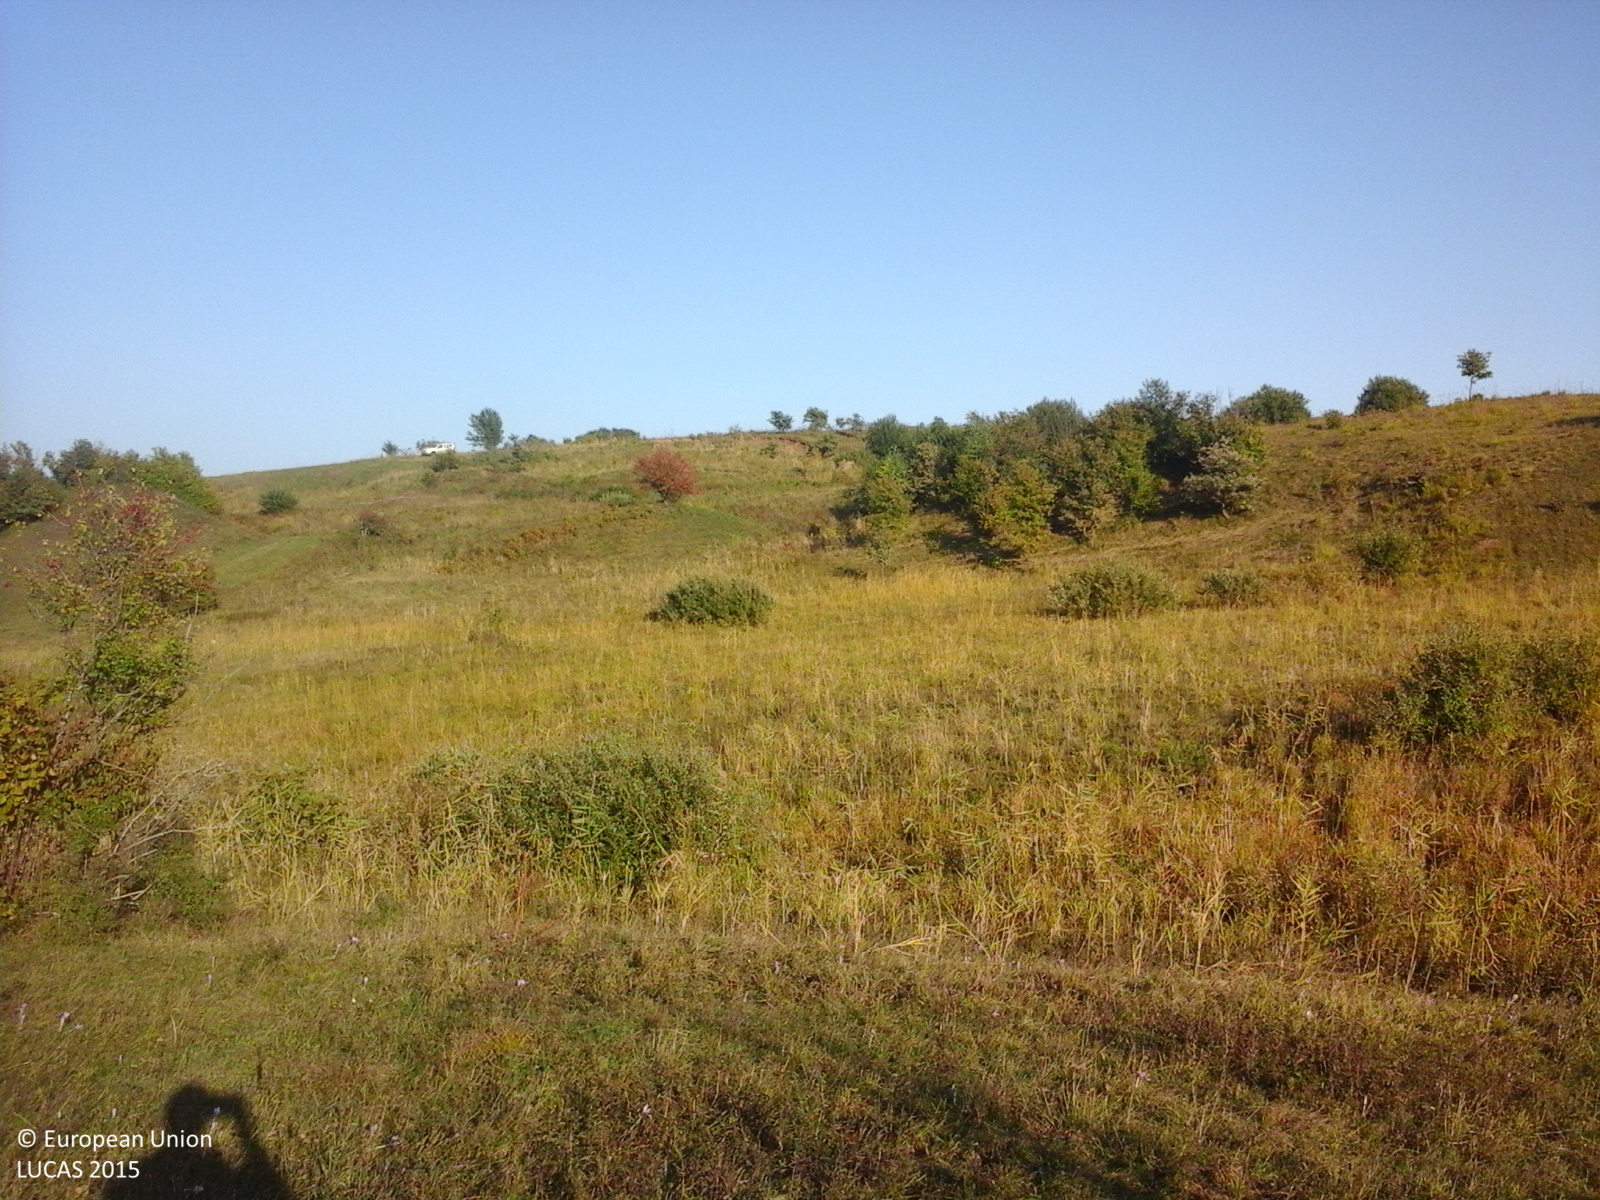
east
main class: Grassland
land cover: Grassland with sparse tree/shrub cover
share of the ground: > 75 %
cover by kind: herbaceous plants 85 %, shrubs 10 %, broadleaved forest trees 5 %
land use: Agriculture (excluding fallow land and kitchen gardens)
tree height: < 5 m
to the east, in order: Grassland with sparse tree/shrub cover
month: October
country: RO
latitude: 46.6036
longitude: 23.5021
